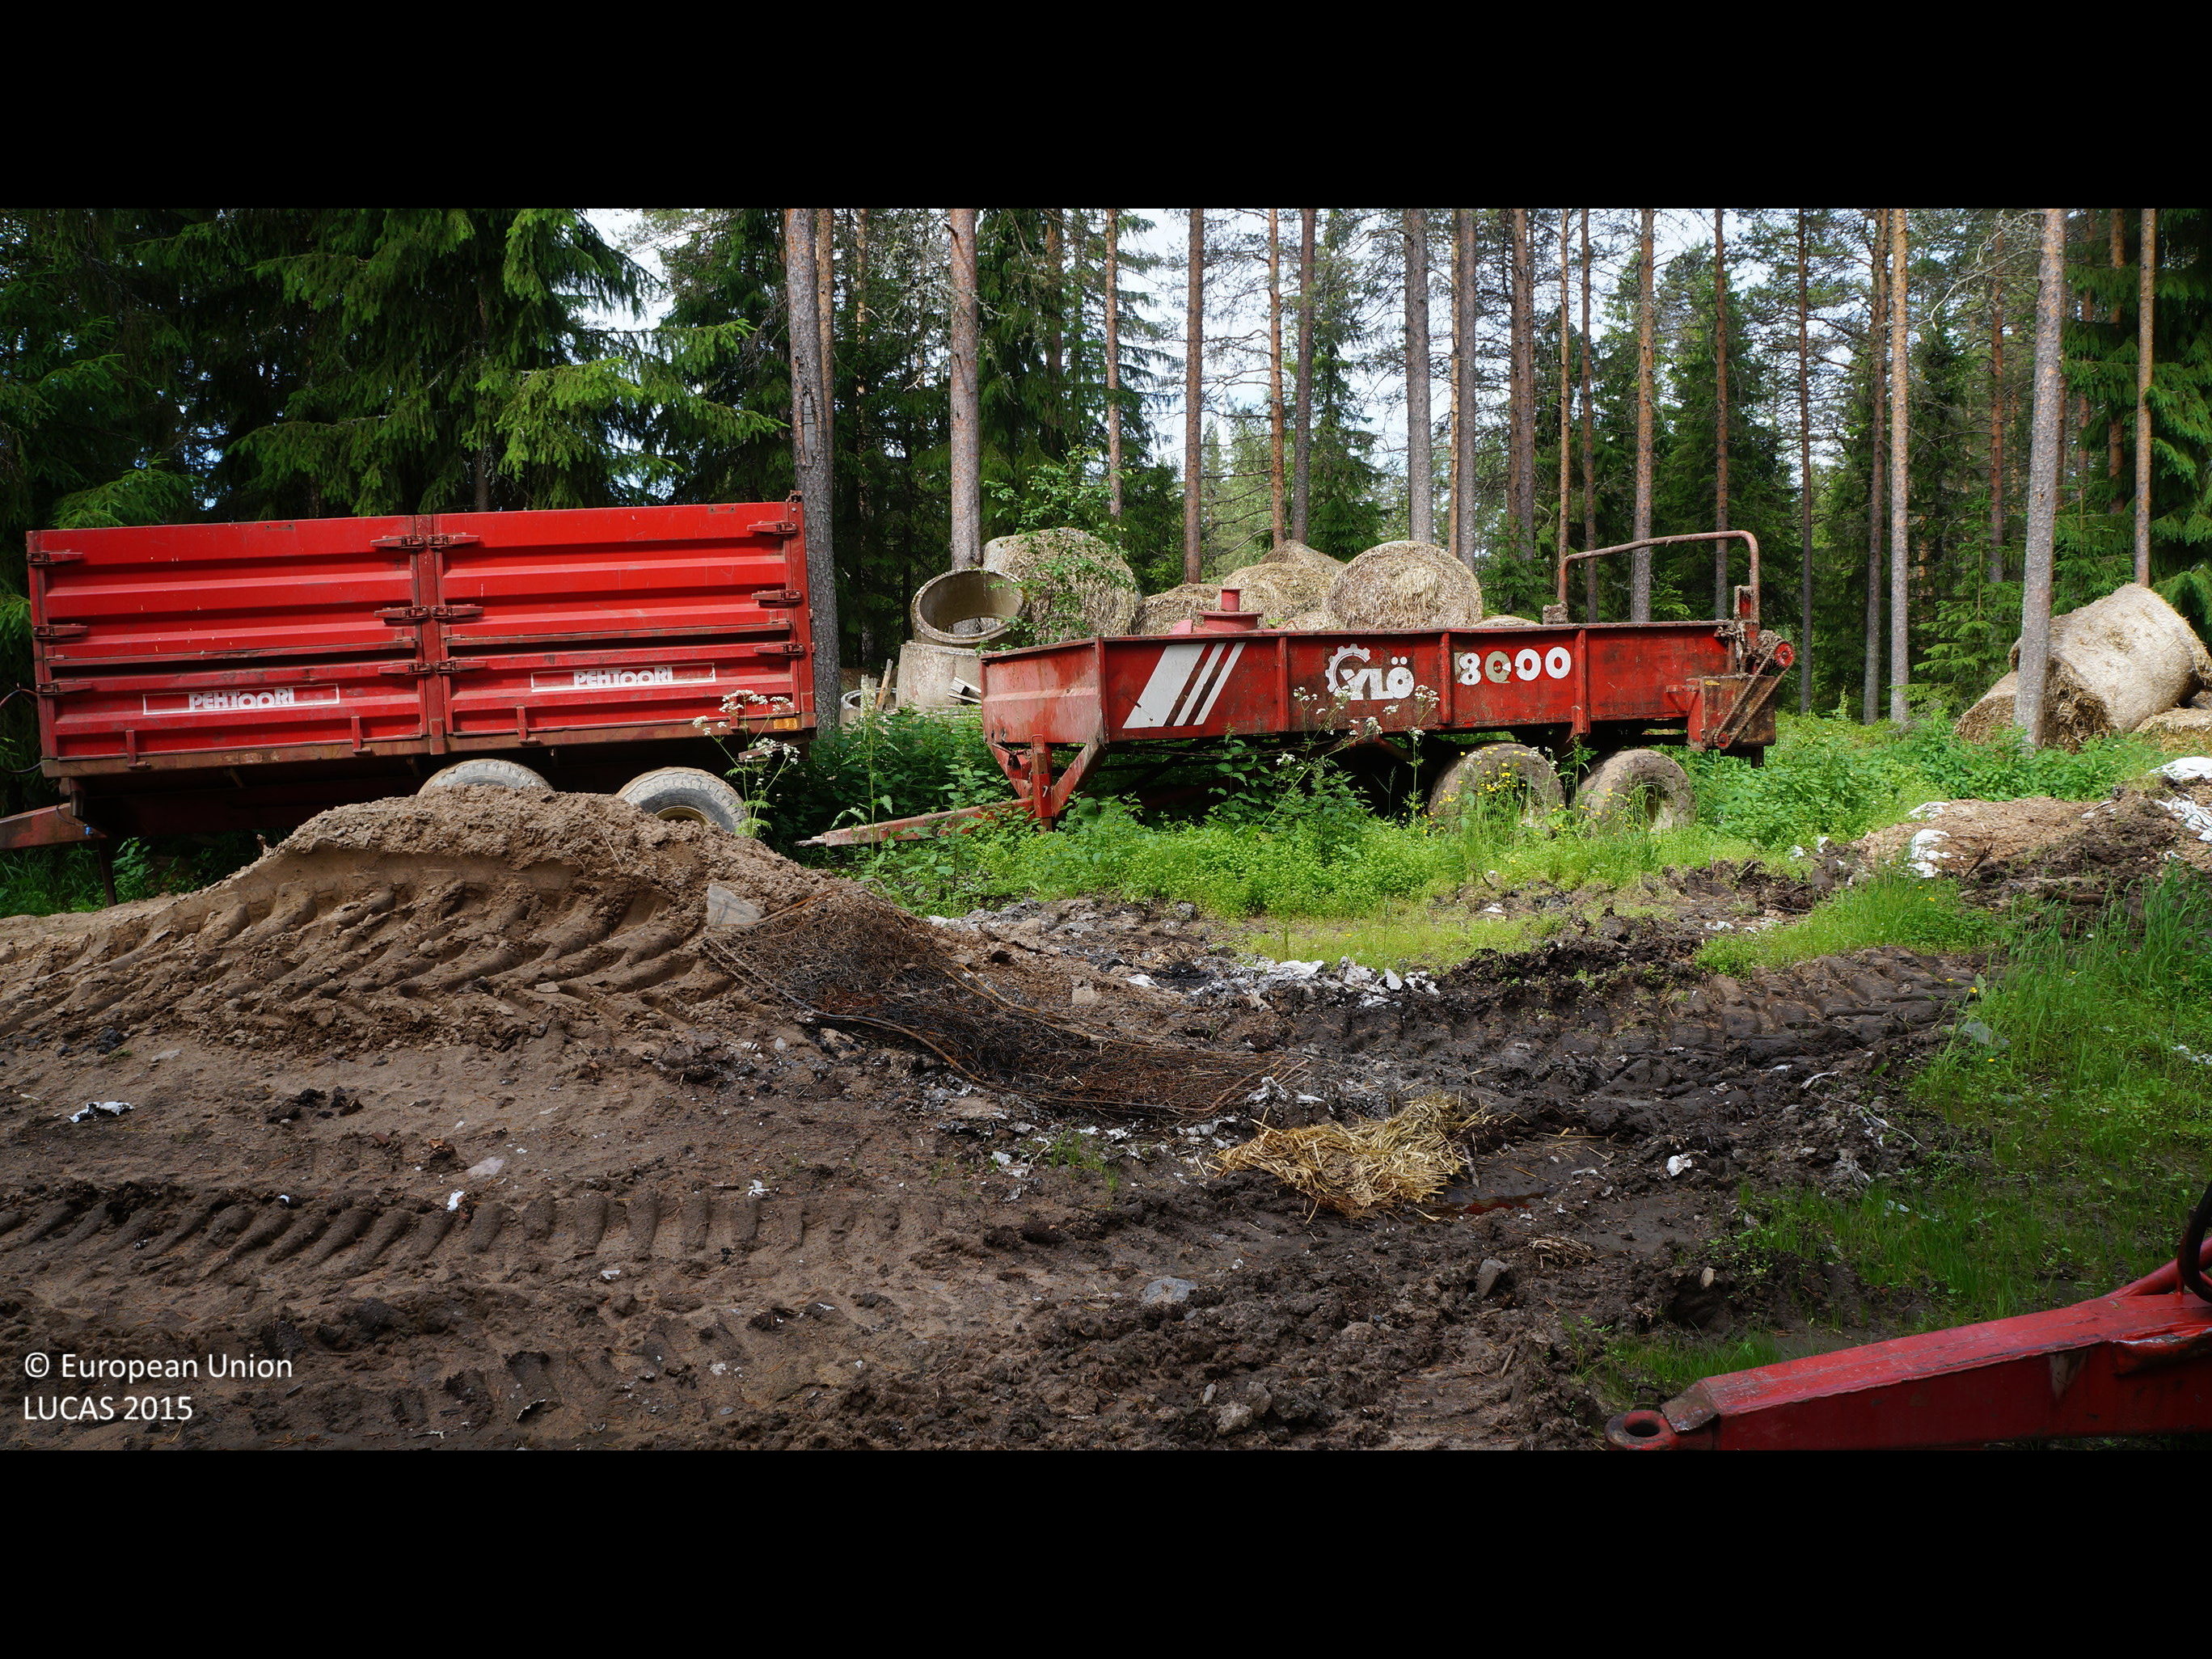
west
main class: Woodland
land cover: Pine dominated coniferous woodland
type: boreal forest
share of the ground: 50 - 75 %
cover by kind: coniferous forest trees 60 %, shrubs 30 %, herbaceous plants 5 %, lichens and mosses 5 %
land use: Forestry
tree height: > 5 m
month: July
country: FI
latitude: 64.3435
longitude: 24.4145
